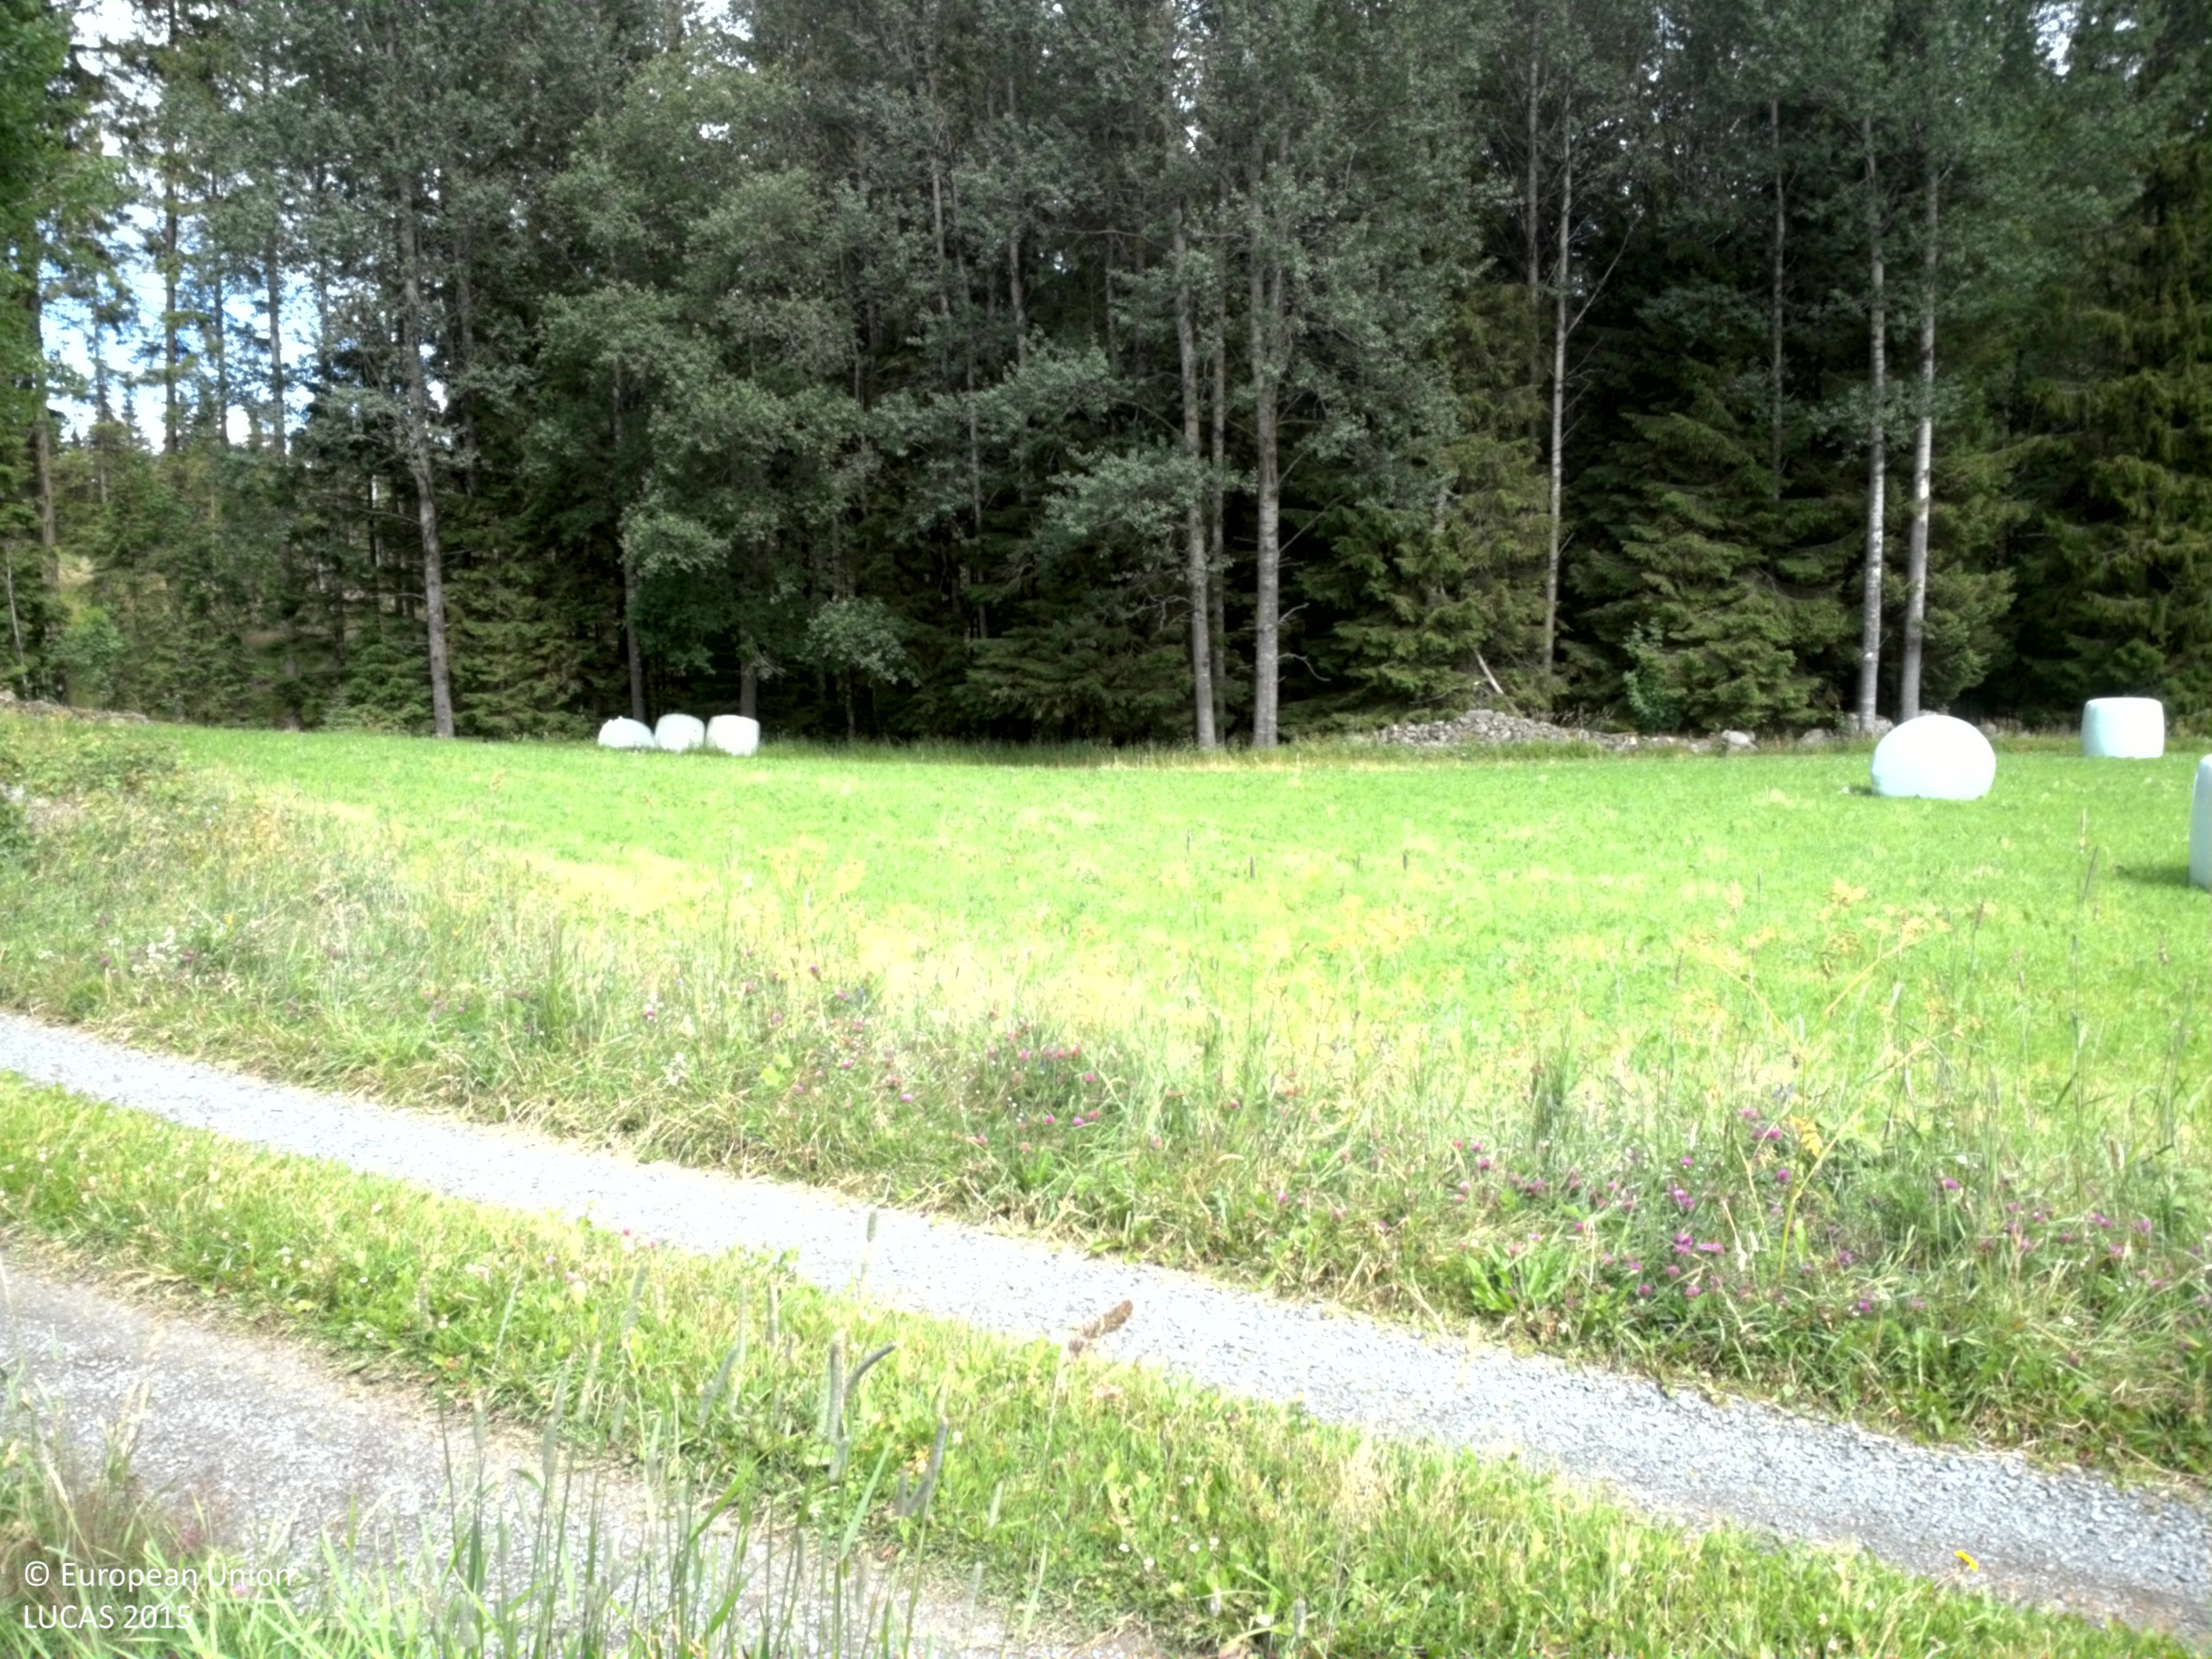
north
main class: Grassland
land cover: Grassland without tree/shrub cover
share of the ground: > 75 %
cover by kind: herbaceous plants 100 %
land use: Semi-natural and natural areas not in use
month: July
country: SE
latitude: 57.6554
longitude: 14.5705
